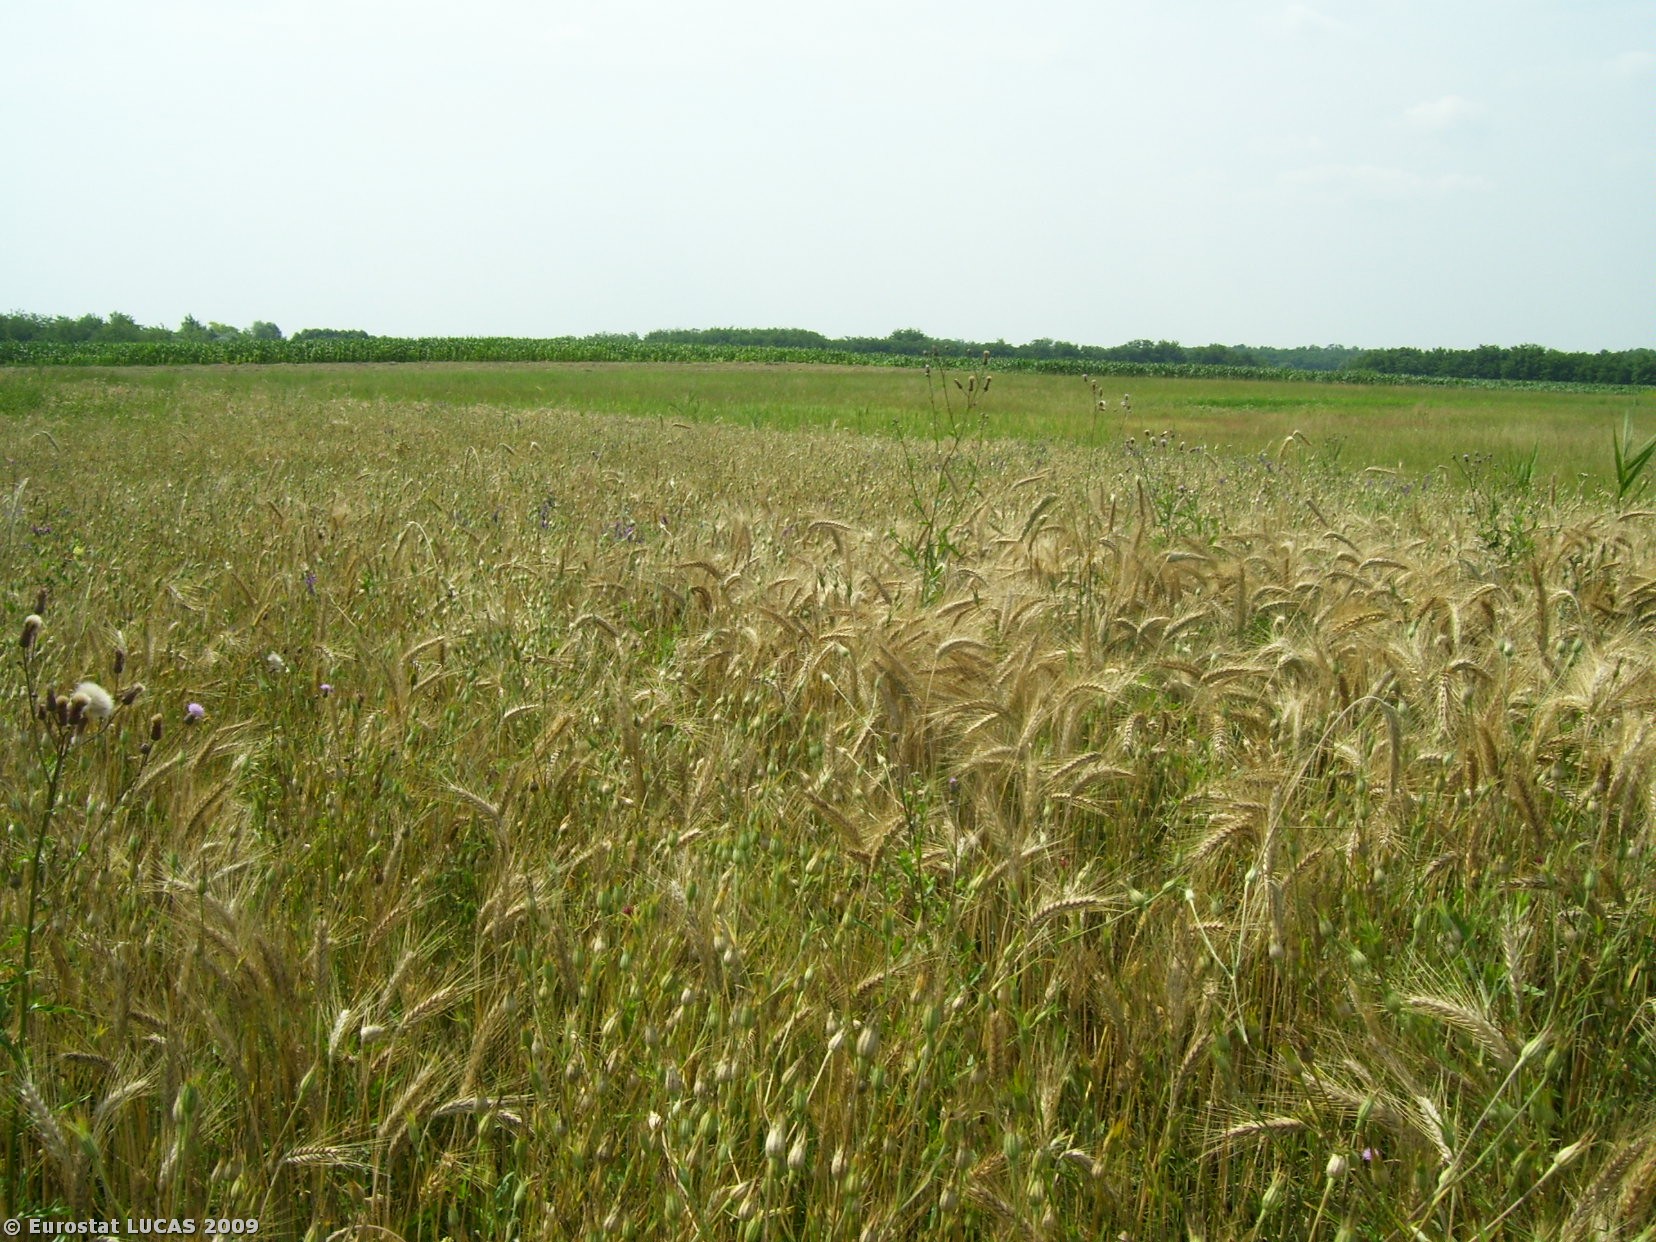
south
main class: Cropland
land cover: Triticale
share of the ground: 50 - 75 %
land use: Agriculture (excluding fallow land and kitchen gardens)
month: July
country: HU
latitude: 47.6211
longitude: 21.8233
